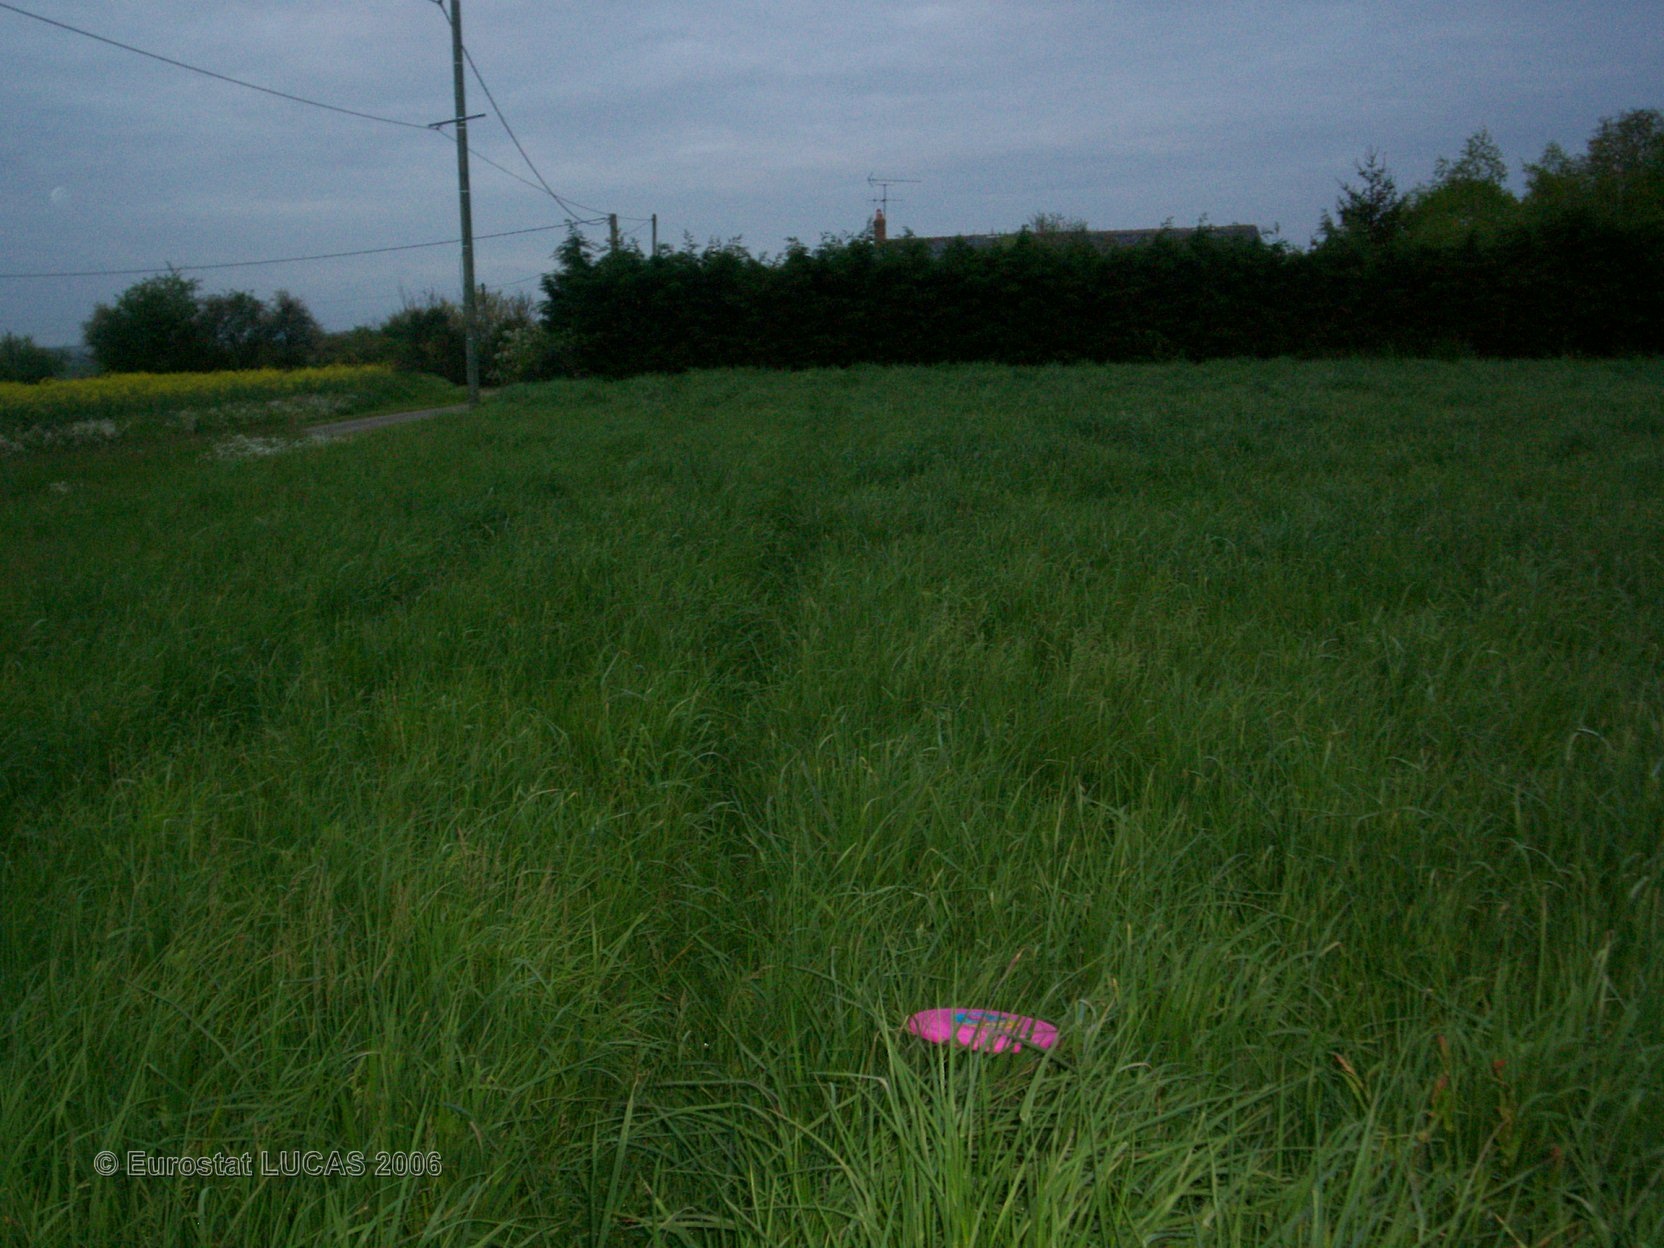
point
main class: Grassland
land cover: Grassland without tree/shrub cover
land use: Agriculture (excluding fallow land and kitchen gardens)
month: May
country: FR
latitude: 47.8604
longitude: -0.1745
